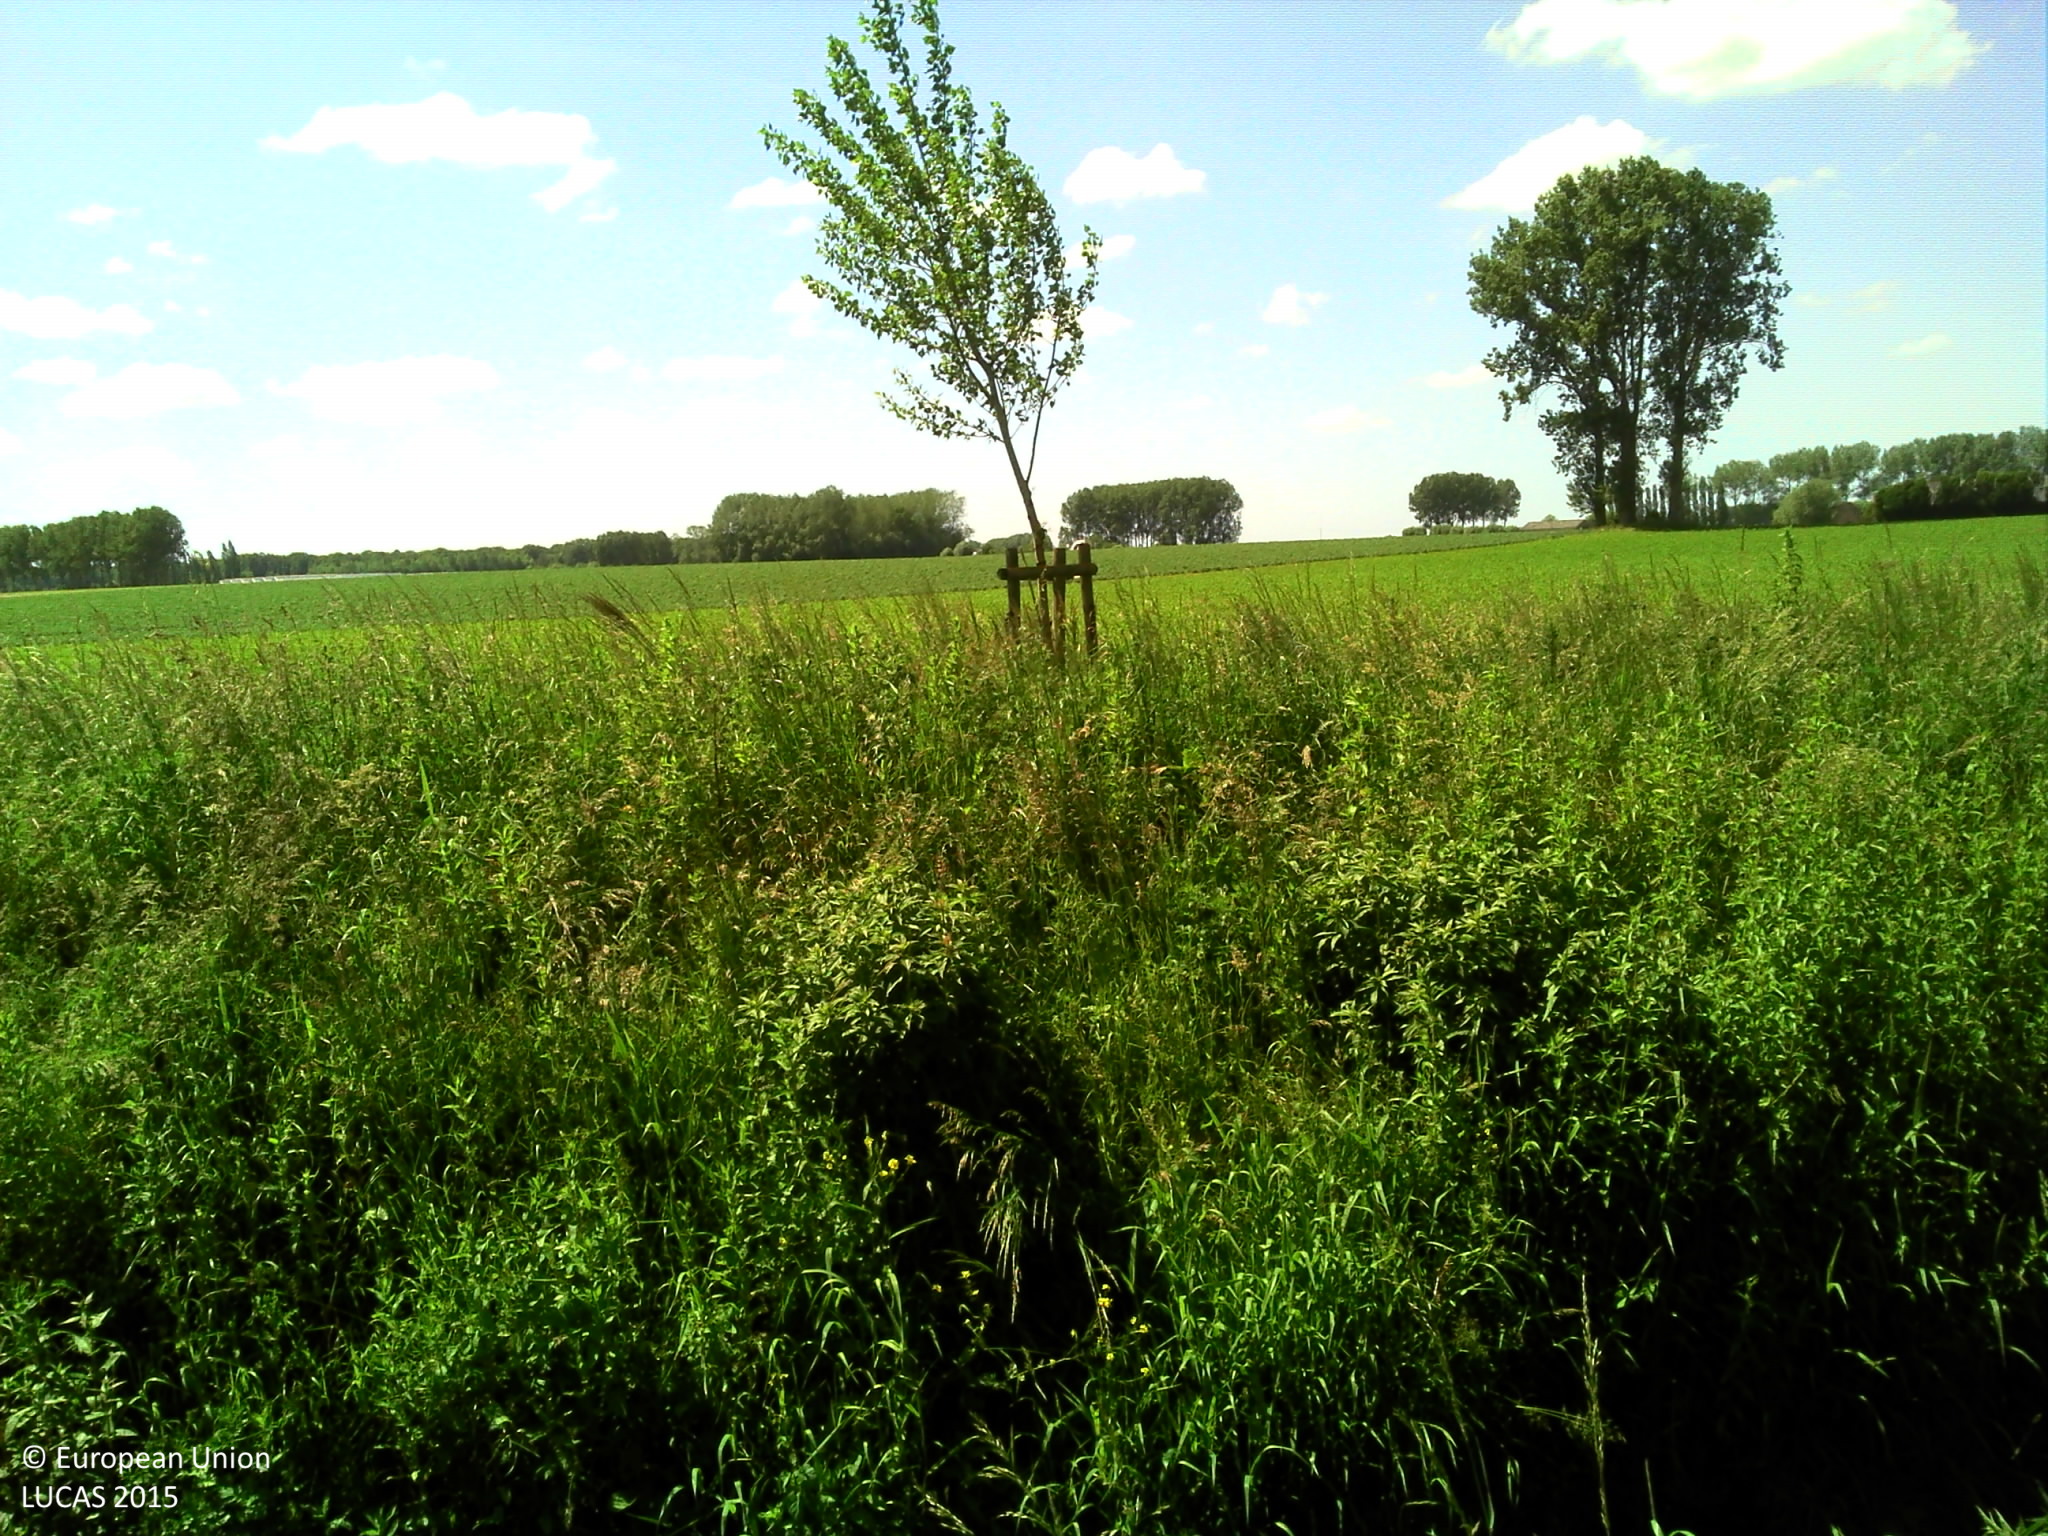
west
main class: Grassland
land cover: Spontaneously vegetated surfaces
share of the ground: > 75 %
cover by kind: herbaceous plants 100 %
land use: Semi-natural and natural areas not in use
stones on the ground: < 10 %
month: June
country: BE
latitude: 50.8779
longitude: 2.8117
